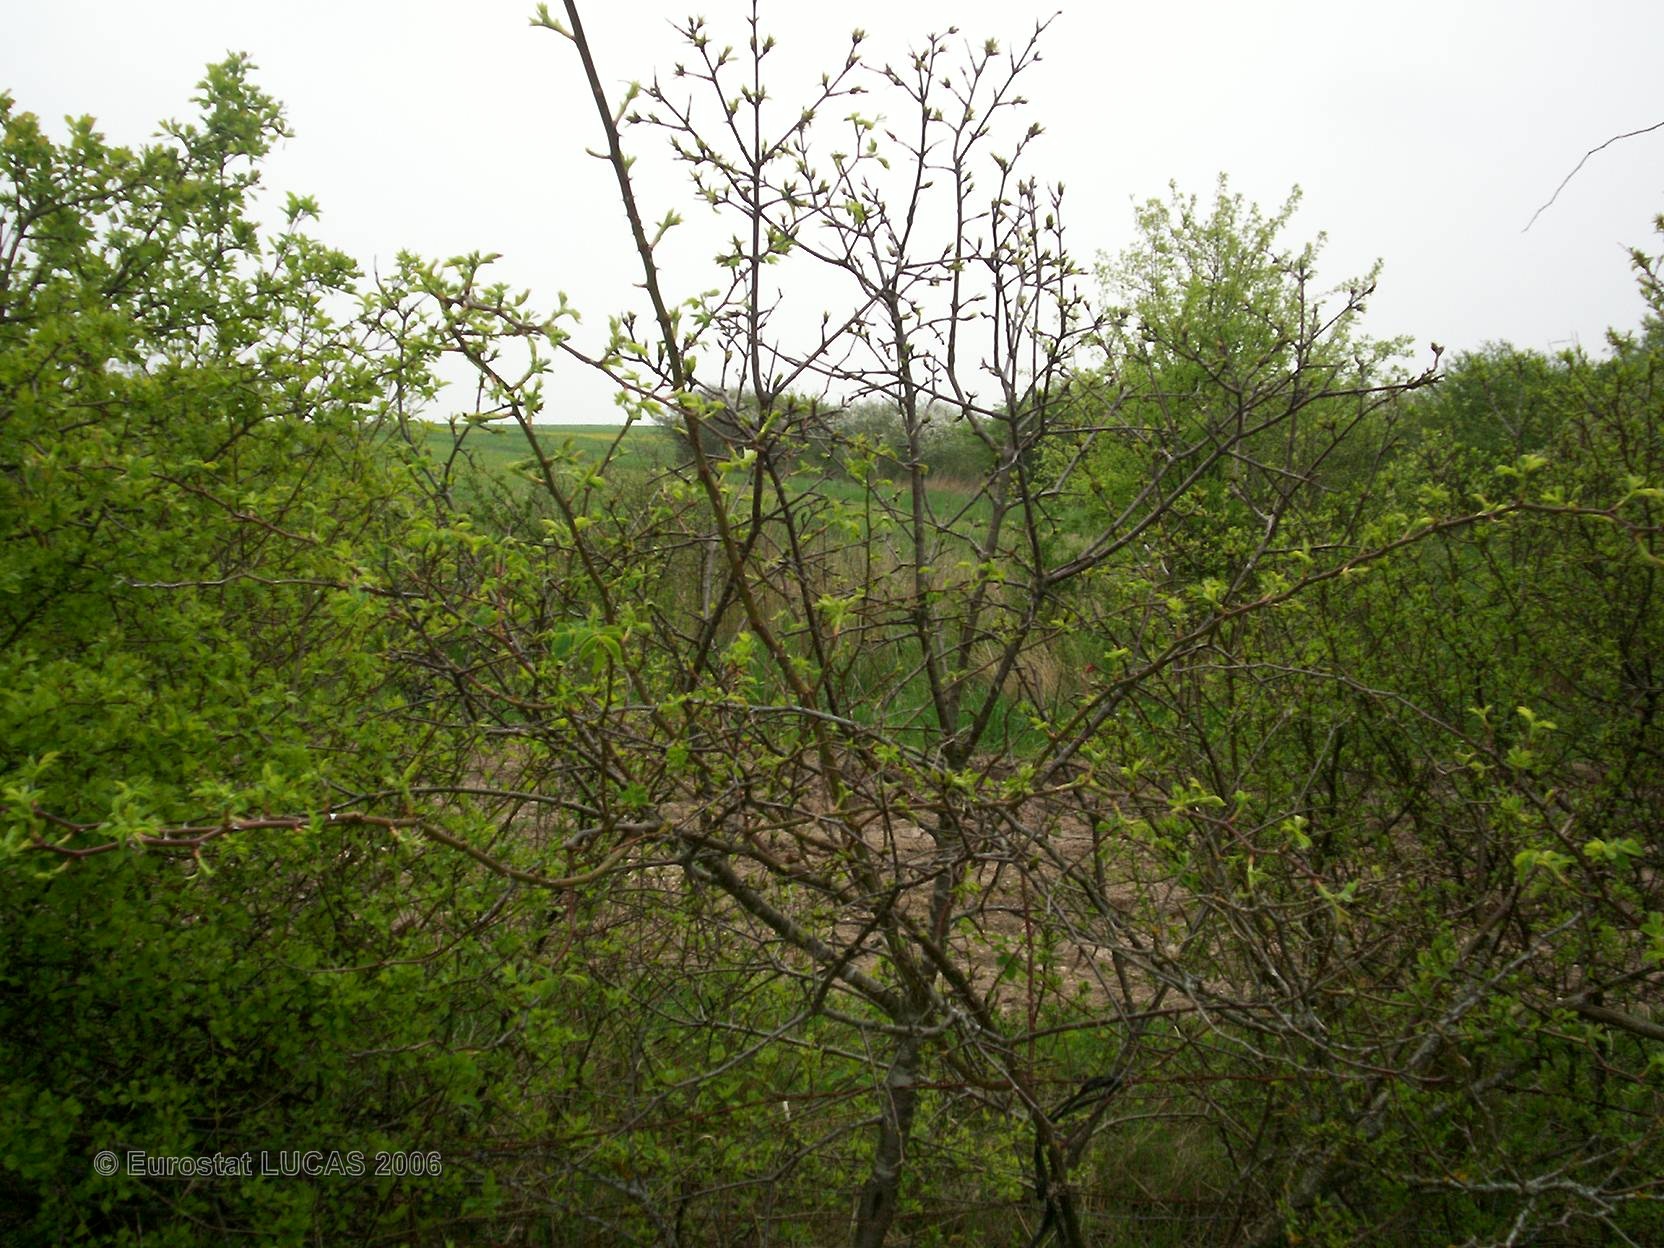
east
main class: Grassland
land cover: Grassland with sparse tree/shrub cover
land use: Agriculture (excluding fallow land and kitchen gardens)
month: April
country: FR
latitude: 48.8777
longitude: 6.7415
